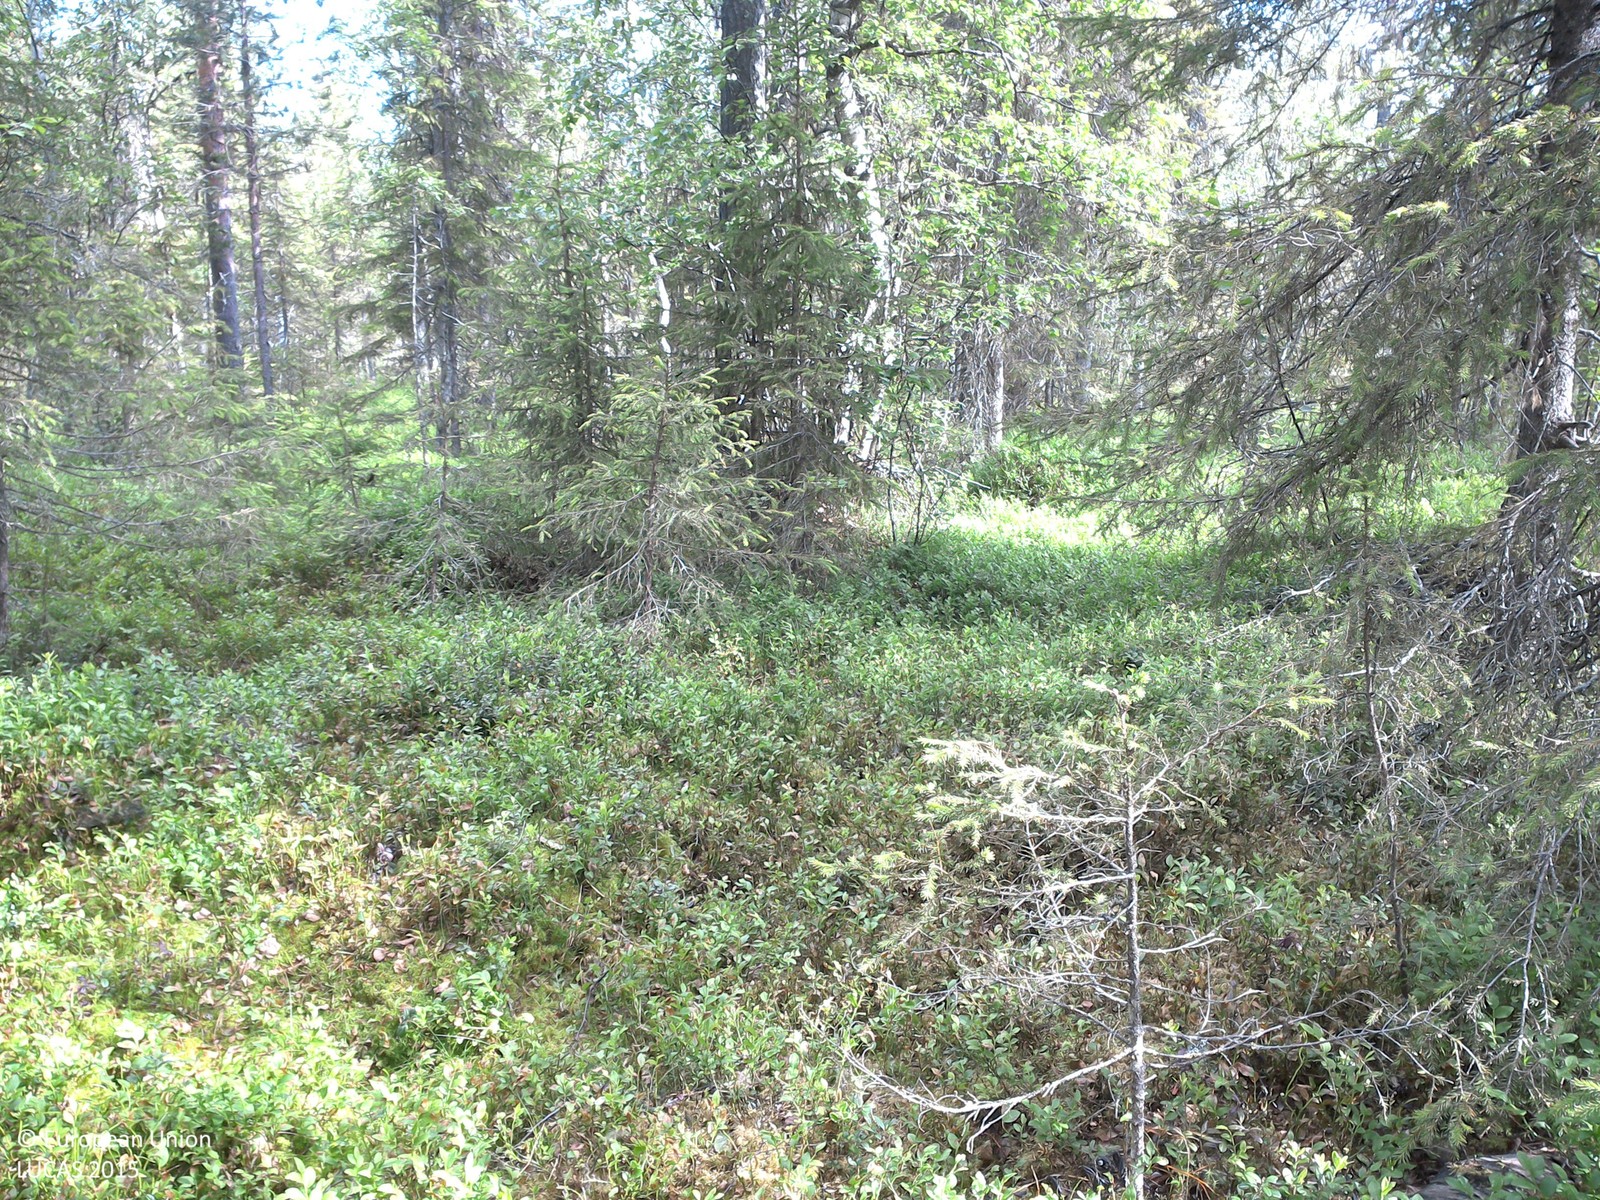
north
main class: Woodland
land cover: Spruce dominated mixed woodland
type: boreal forest
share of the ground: 25 - 50 %
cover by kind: shrubs 55 %, coniferous forest trees 30 %, broadleaved forest trees 10 %, lichens and mosses 5 %
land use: Forestry
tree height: > 5 m
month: July
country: SE
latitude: 67.1392
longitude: 22.6744
